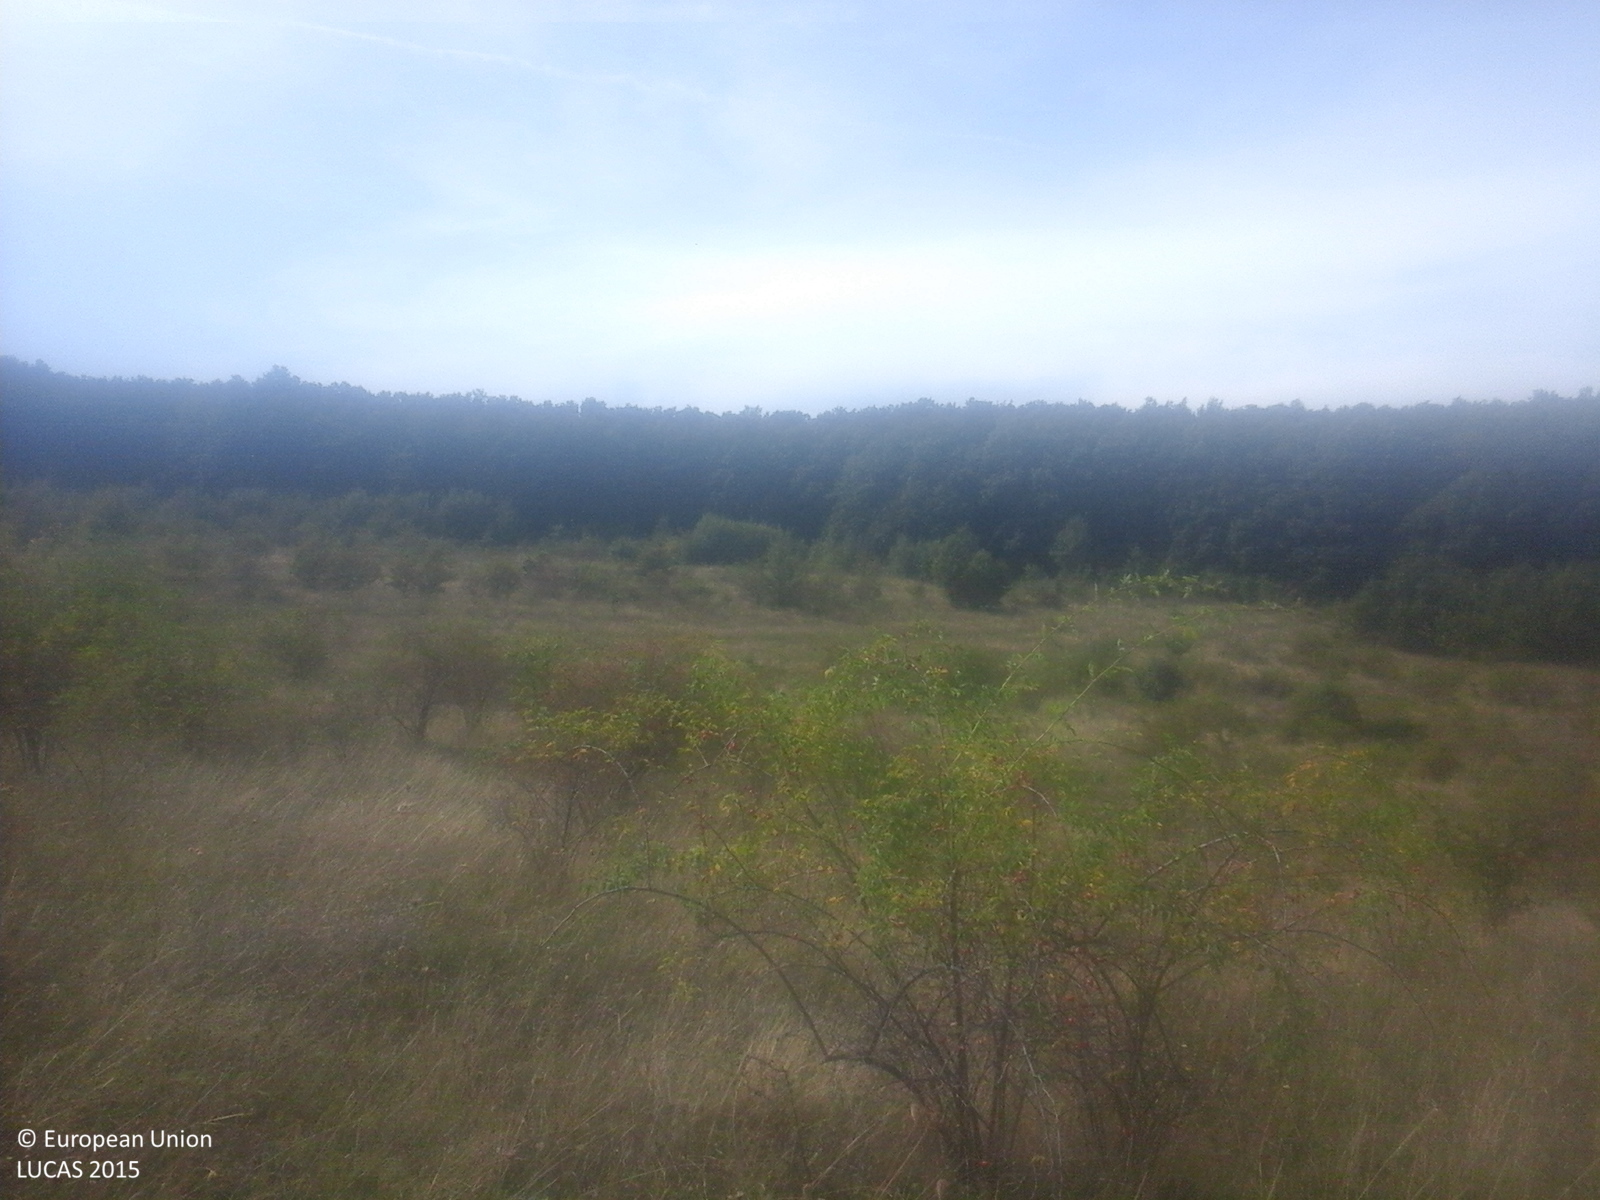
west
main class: Shrubland
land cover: Shrubland without tree cover
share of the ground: > 75 %
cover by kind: shrubs 60 %, herbaceous plants 40 %
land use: Fallow land
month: September
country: RO
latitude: 47.0805
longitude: 23.6265
